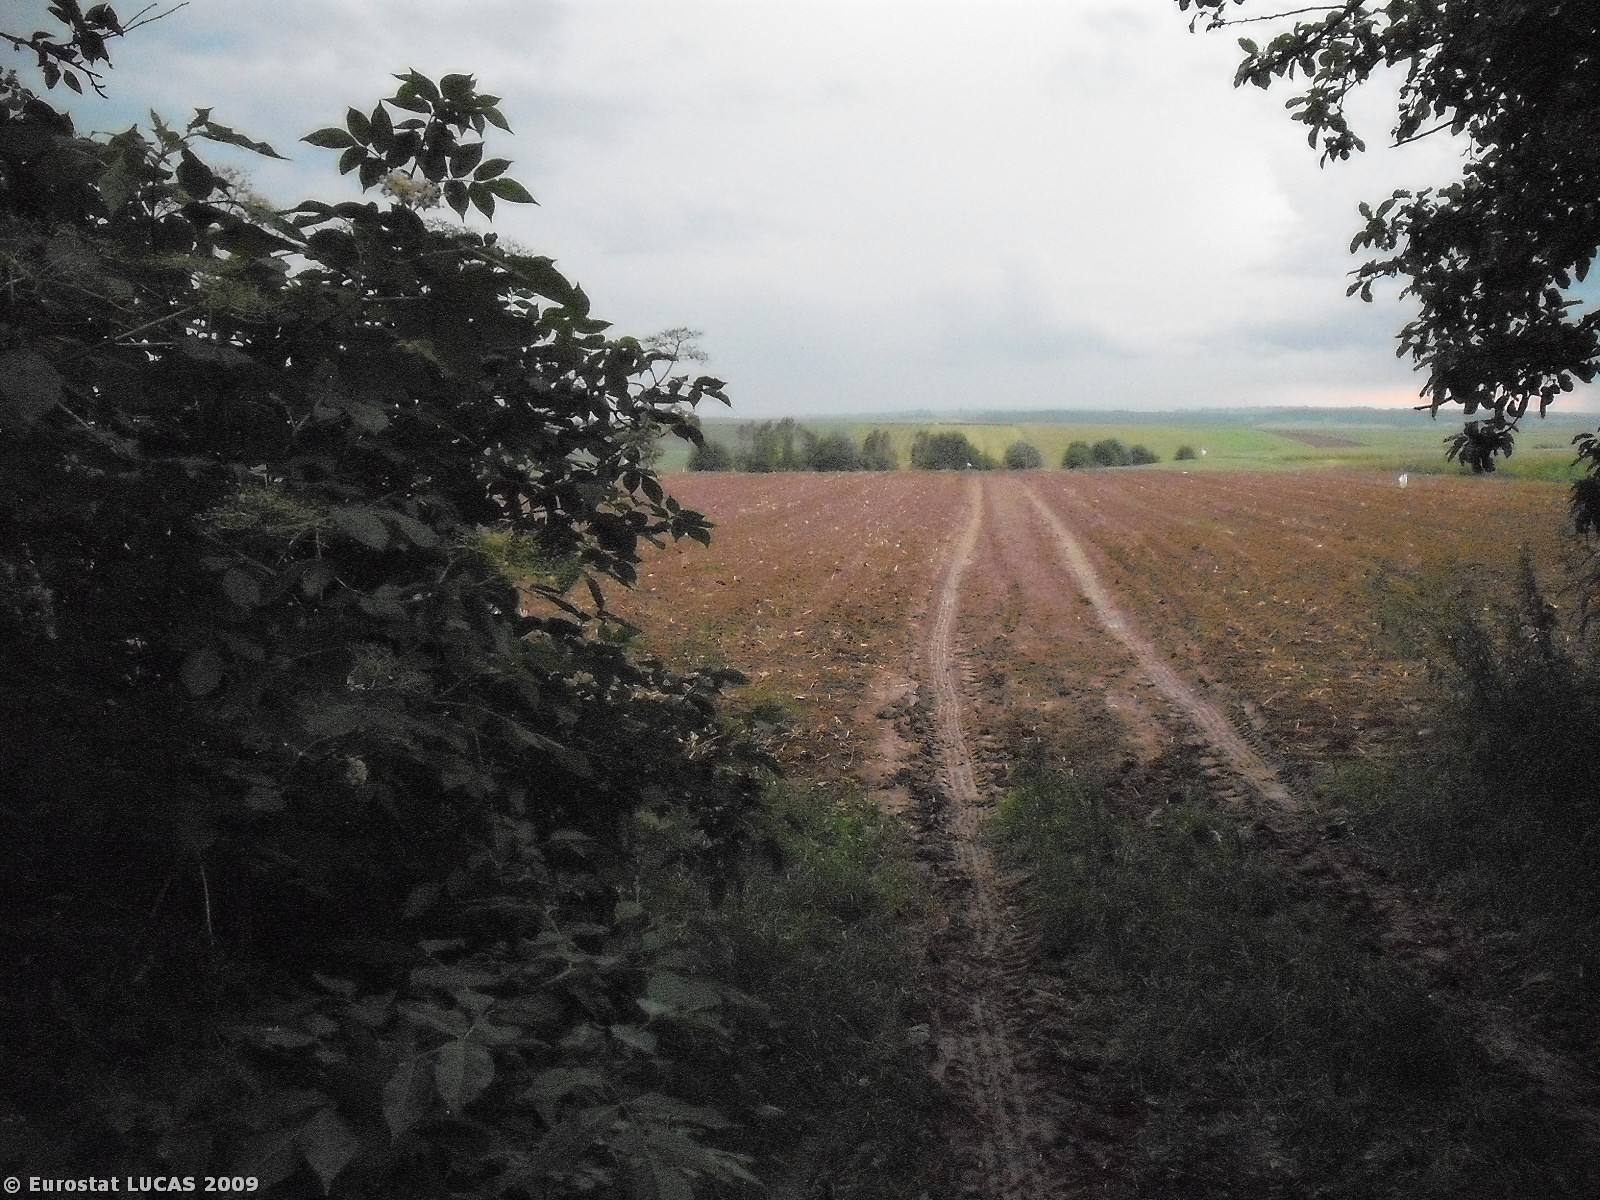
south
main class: Woodland
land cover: Broadleaved woodland
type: mesophytic deciduous forest
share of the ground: > 75 %
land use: Unused
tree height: > 5 m
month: June
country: PL
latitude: 50.7859
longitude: 21.2676
